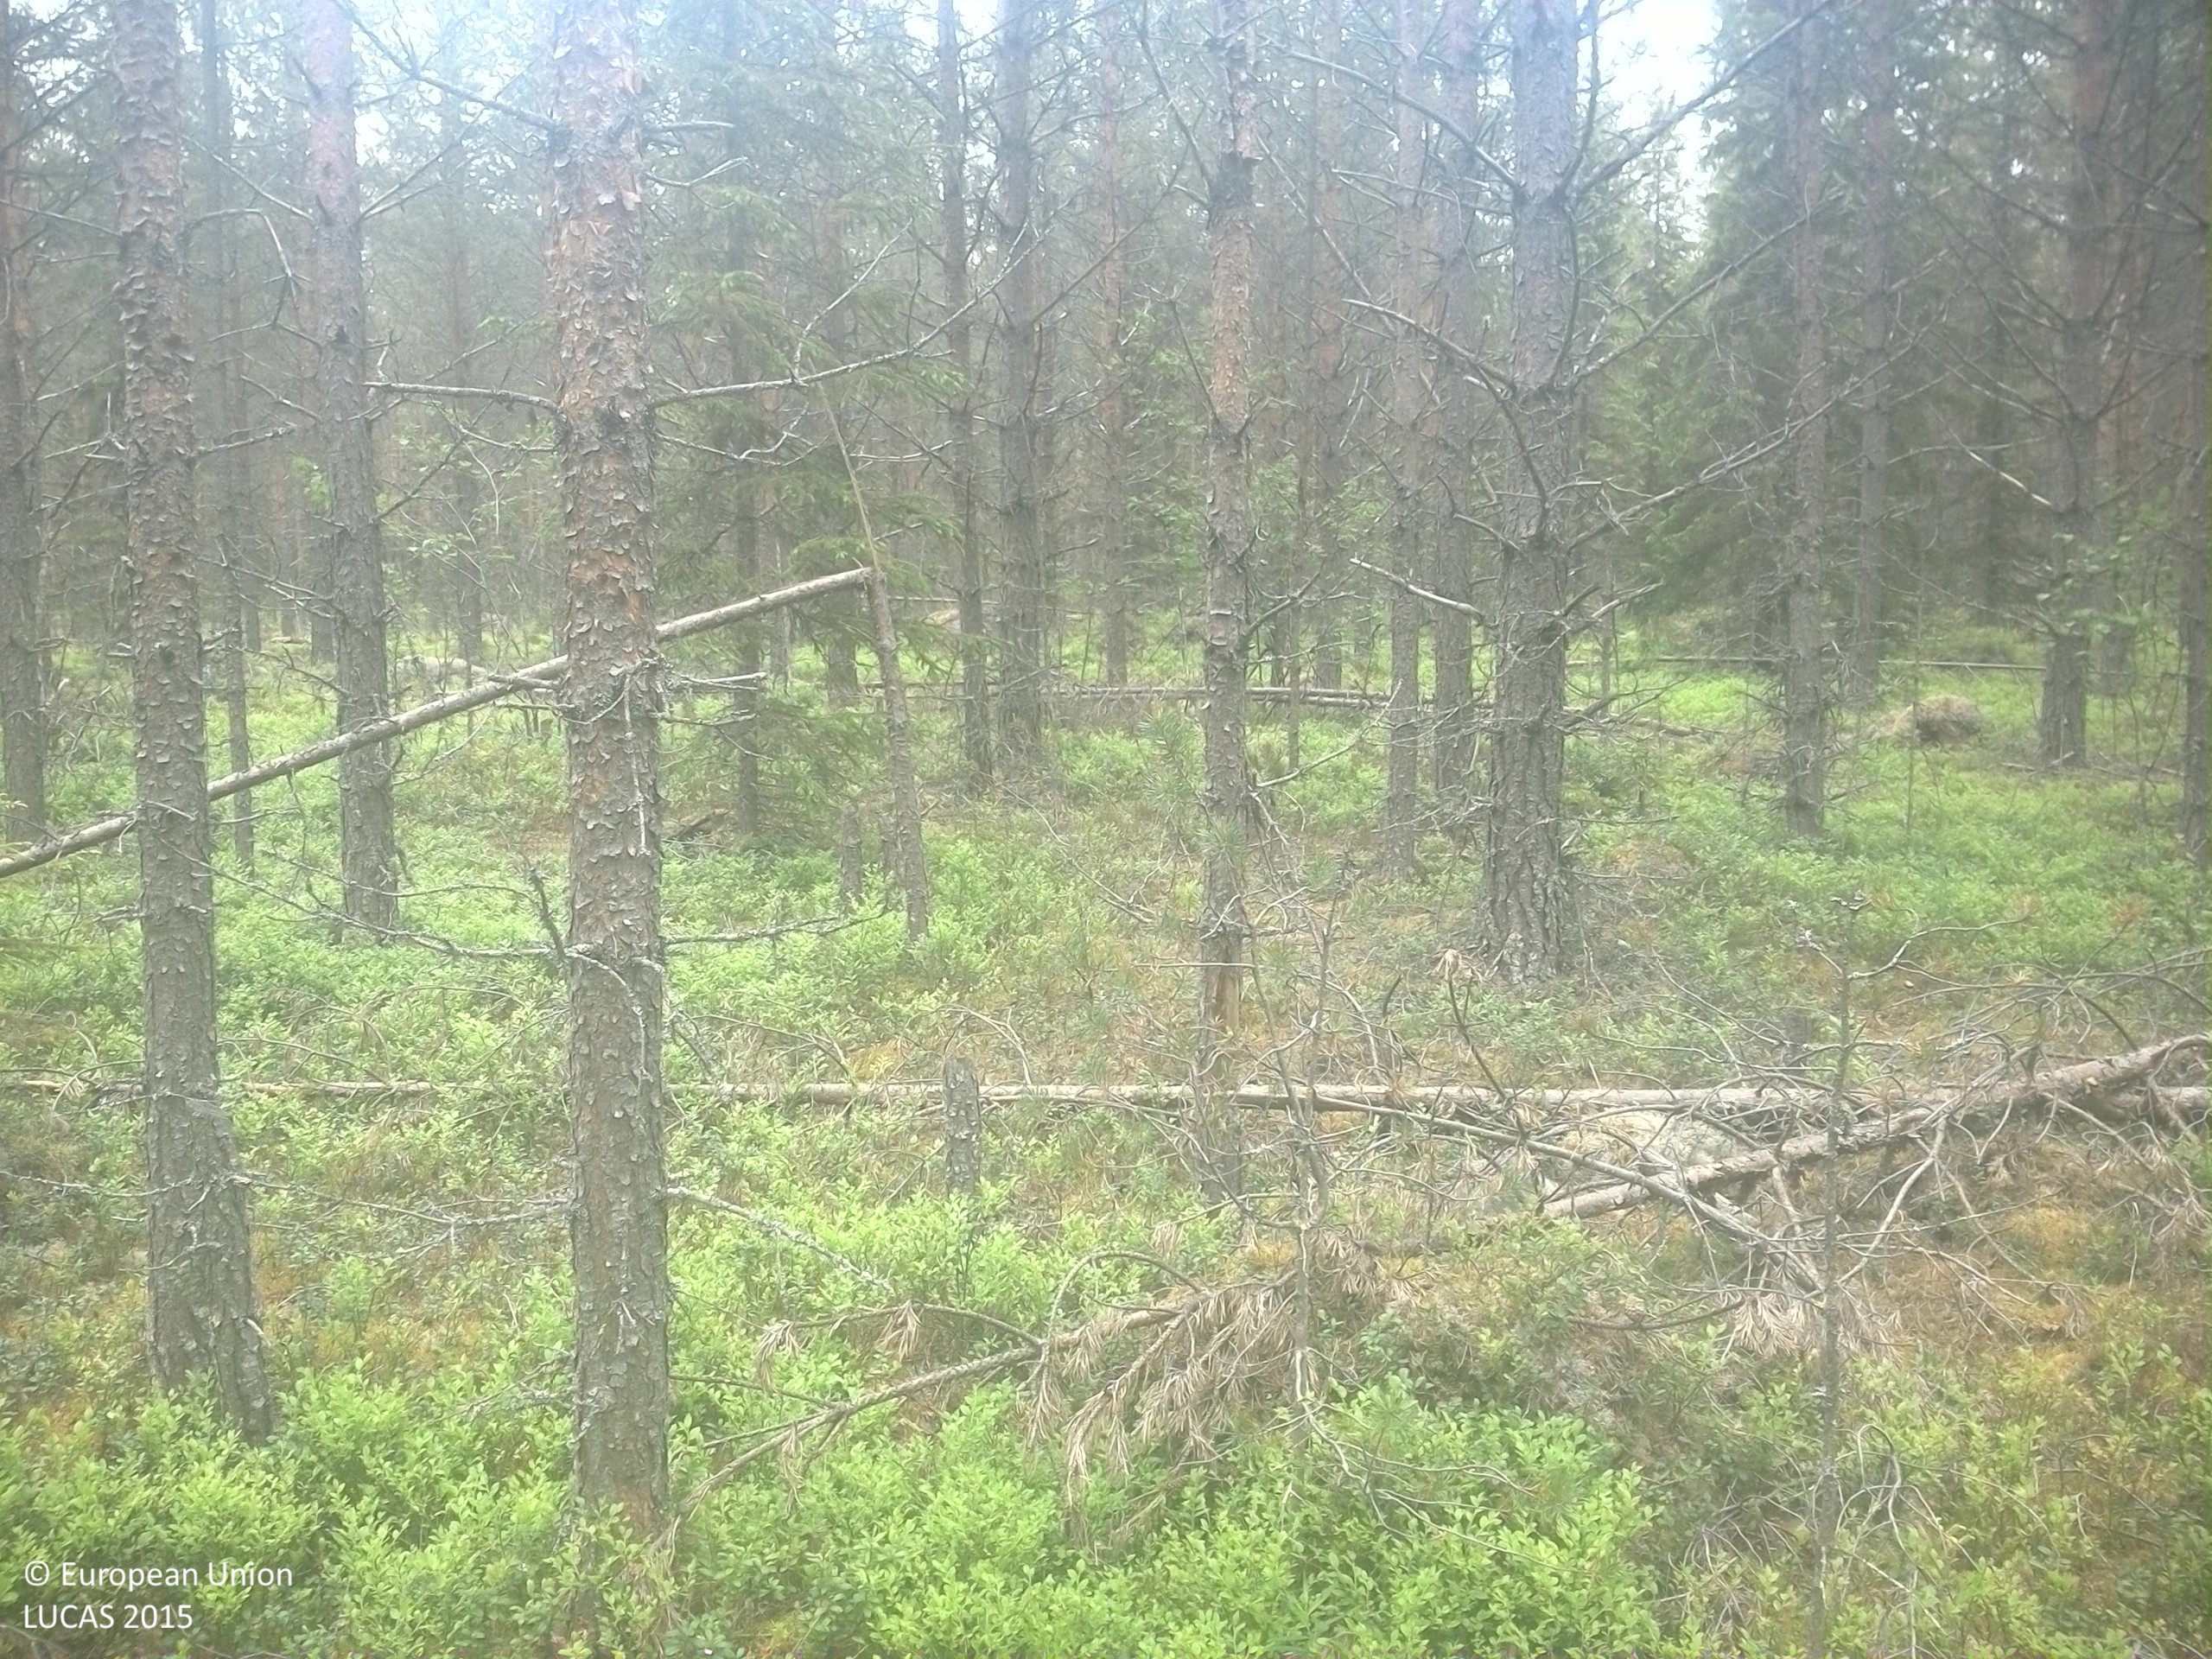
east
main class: Woodland
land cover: Pine dominated coniferous woodland
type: boreal forest
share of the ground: 50 - 75 %
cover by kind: coniferous forest trees 70 %, shrubs 30 %
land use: Forestry
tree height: > 5 m
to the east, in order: Pine dominated coniferous woodland
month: June
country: SE
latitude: 63.4929
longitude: 17.9073
